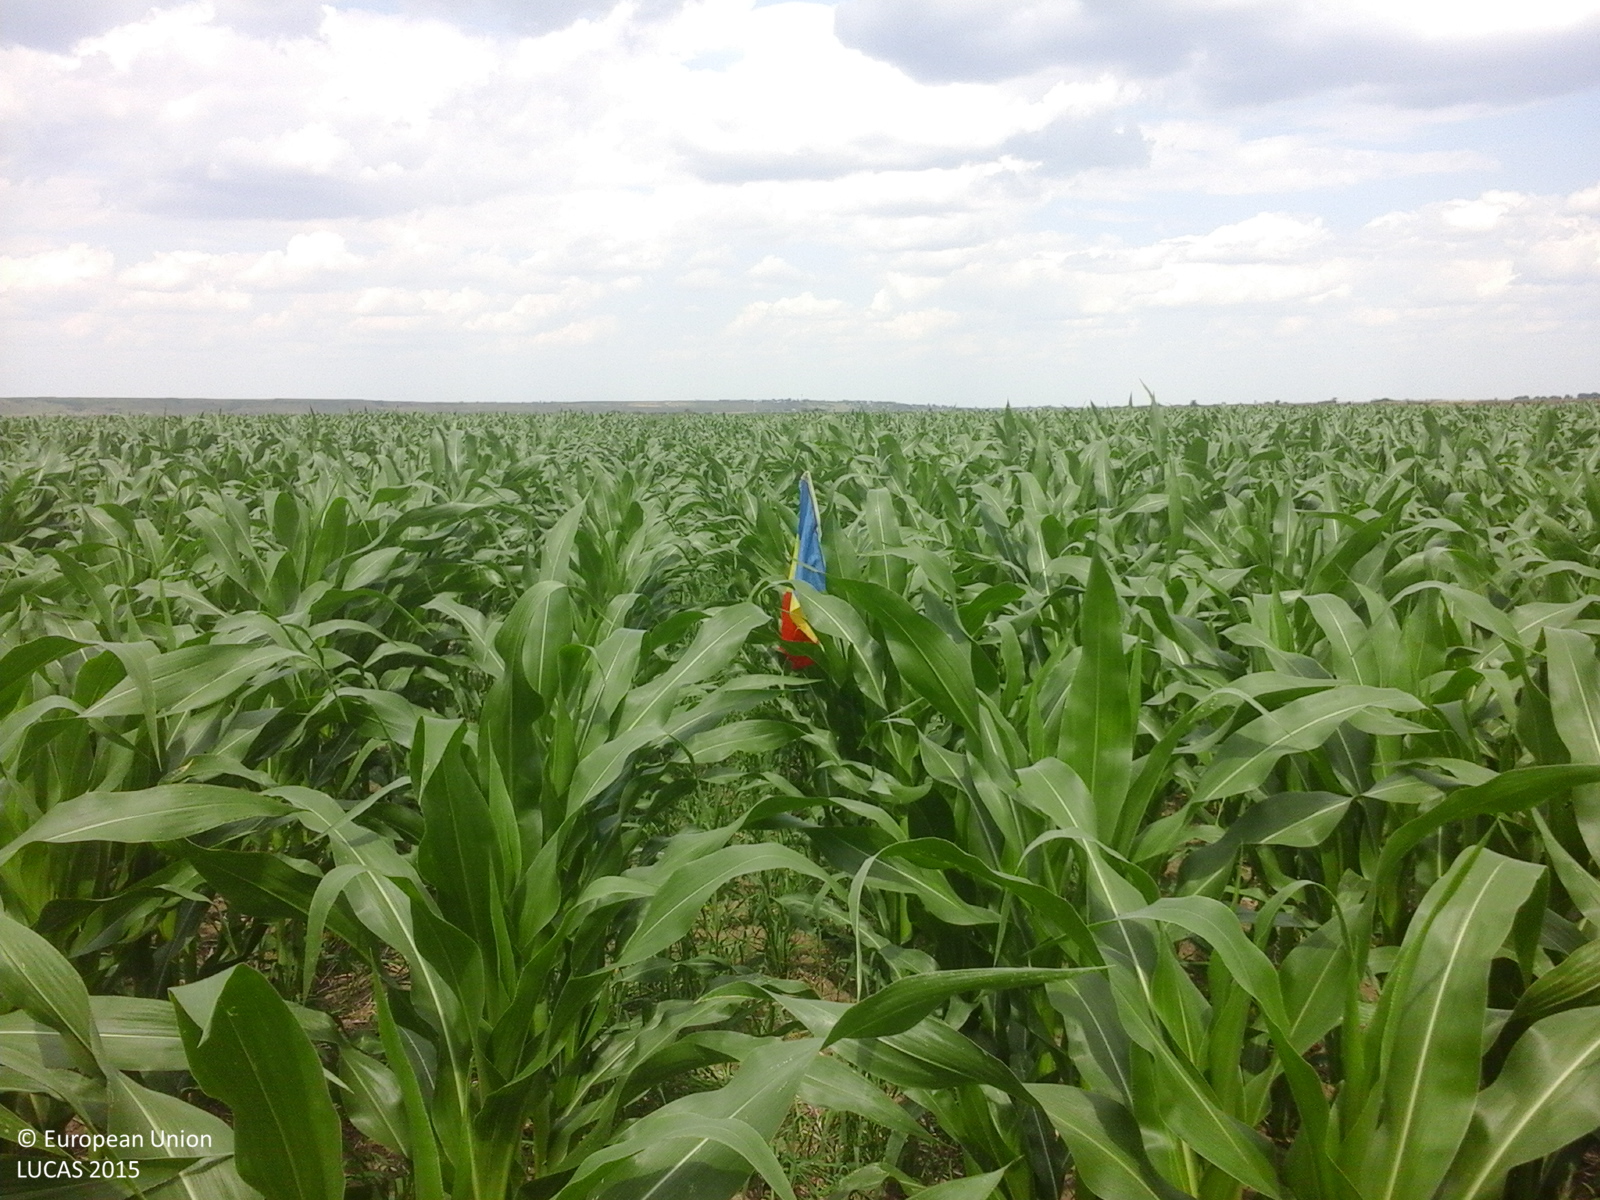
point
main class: Cropland
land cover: Maize
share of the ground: > 75 %
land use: Agriculture (excluding fallow land and kitchen gardens)
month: June
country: RO
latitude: 44.0832
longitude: 26.5086
